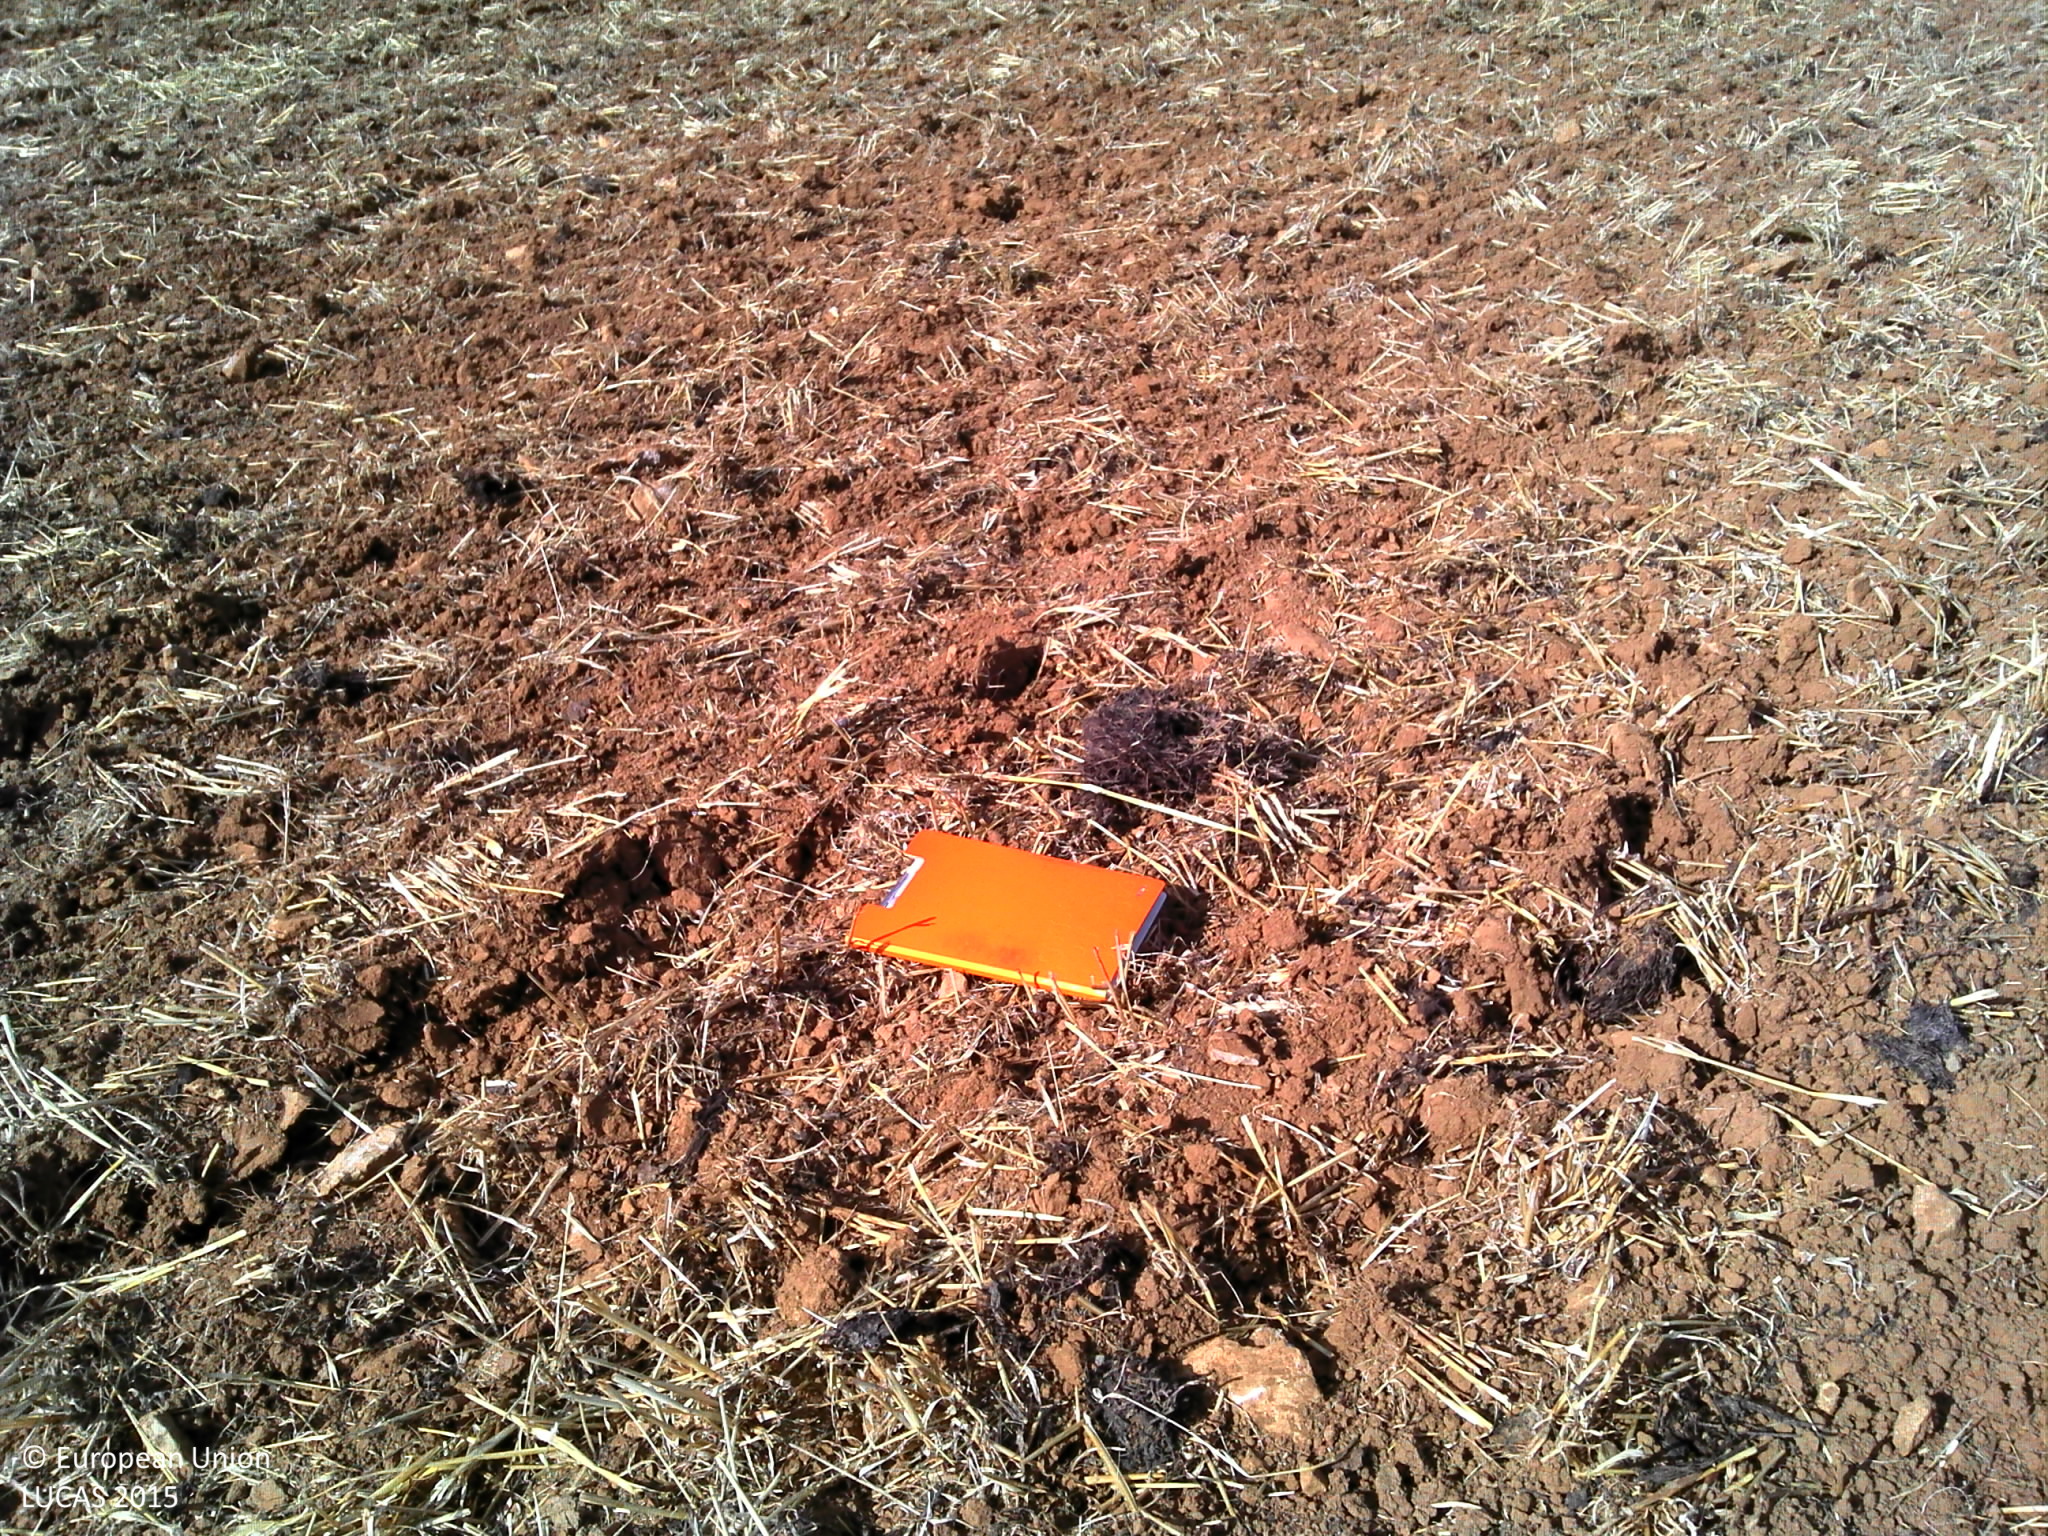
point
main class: Cropland
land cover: Barley
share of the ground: 10 - 25 %
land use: Agriculture (excluding fallow land and kitchen gardens)
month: July
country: FR
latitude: 47.7219
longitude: 5.1874
